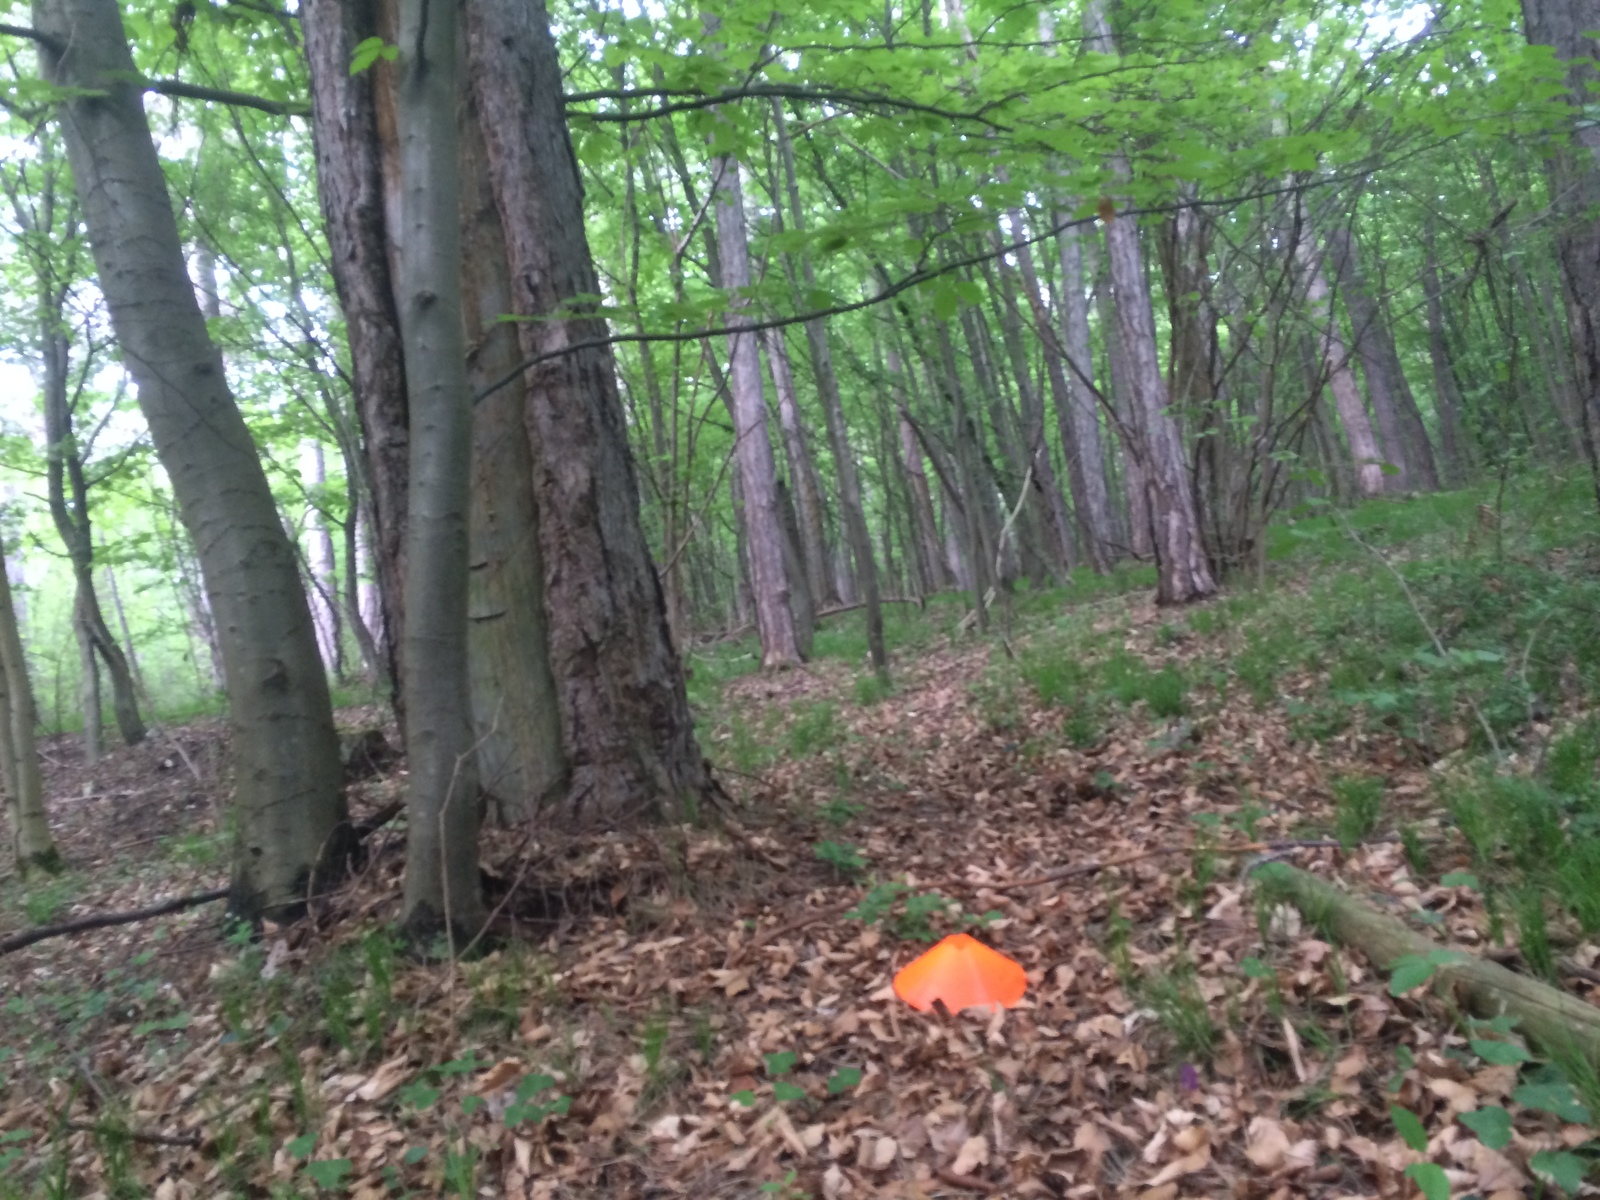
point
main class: Woodland
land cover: Pine dominated mixed woodland
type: hemiboreal forest and nemoral coniferous forest and mixed broadleaved-coniferous forest
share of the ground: > 75 %
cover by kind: coniferous forest trees 50 %, broadleaved forest trees 50 %
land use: Forestry
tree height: > 5 m
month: May
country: AT
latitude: 47.9272
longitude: 16.1199
